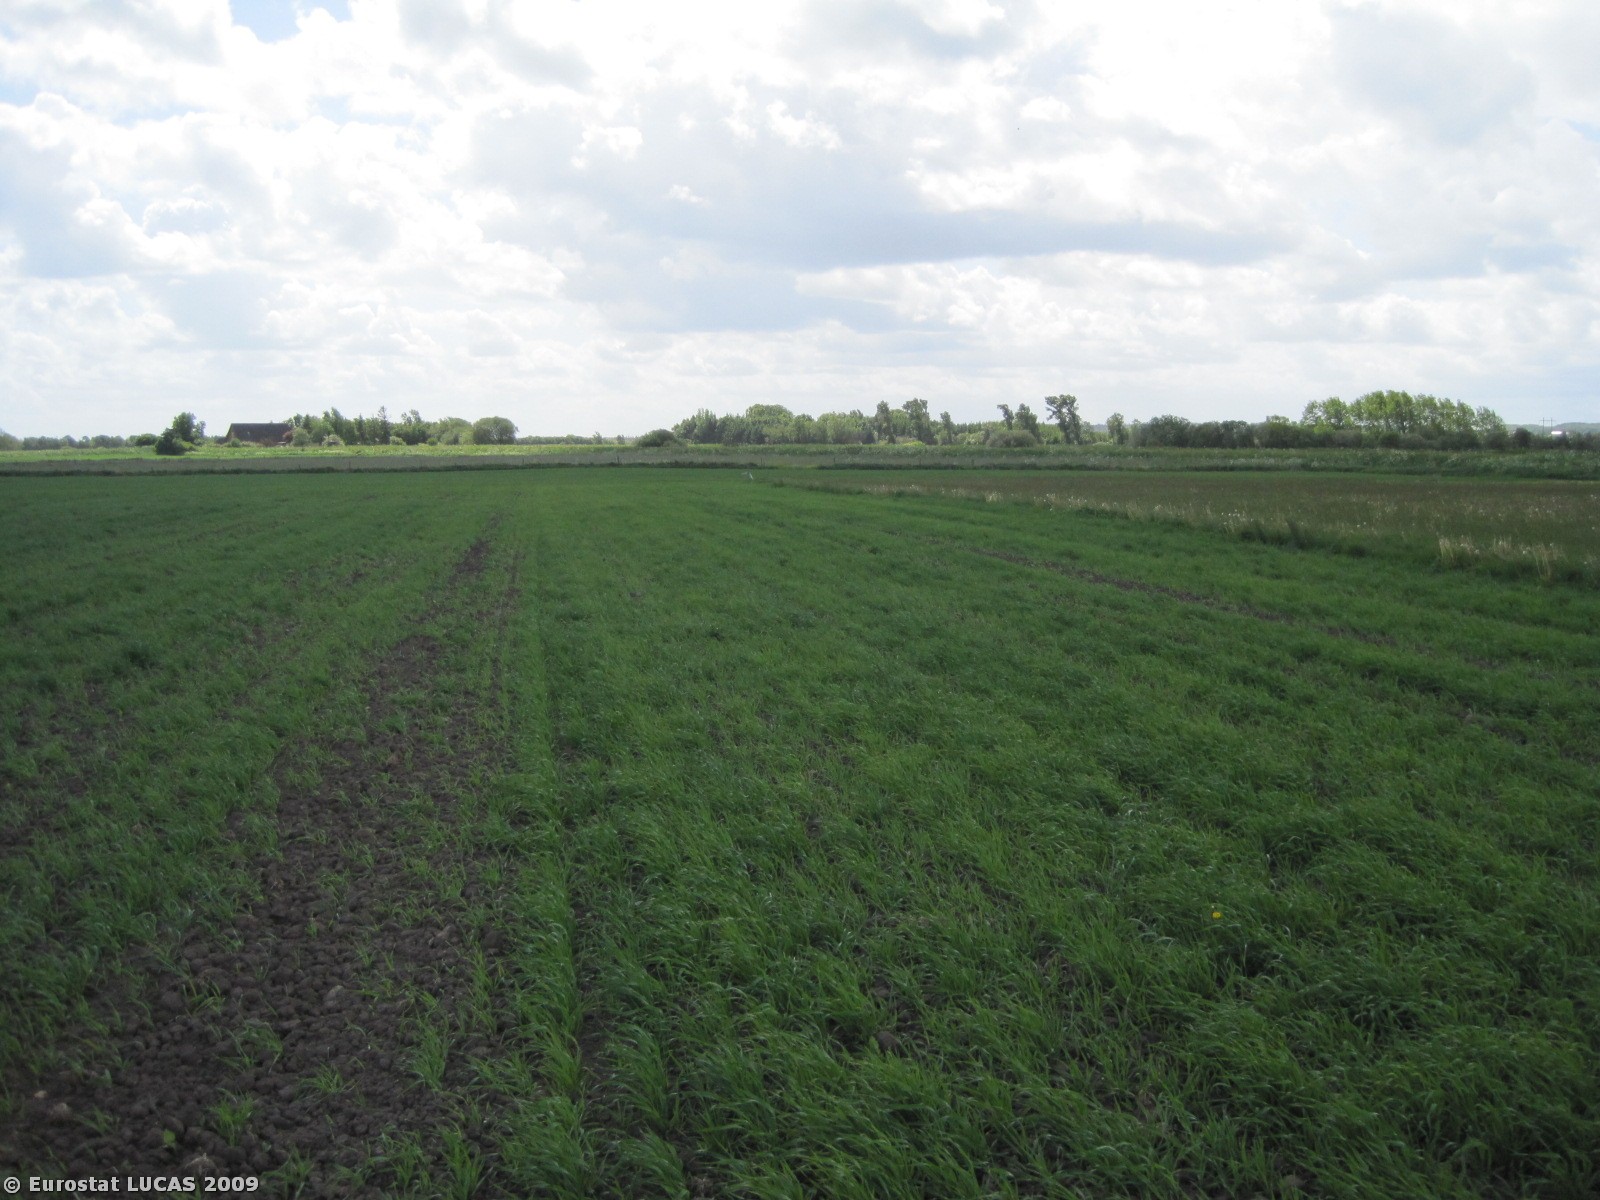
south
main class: Cropland
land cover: Barley
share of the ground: 50 - 75 %
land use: Agriculture (excluding fallow land and kitchen gardens)
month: May
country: DK
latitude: 56.5651
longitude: 9.8212
